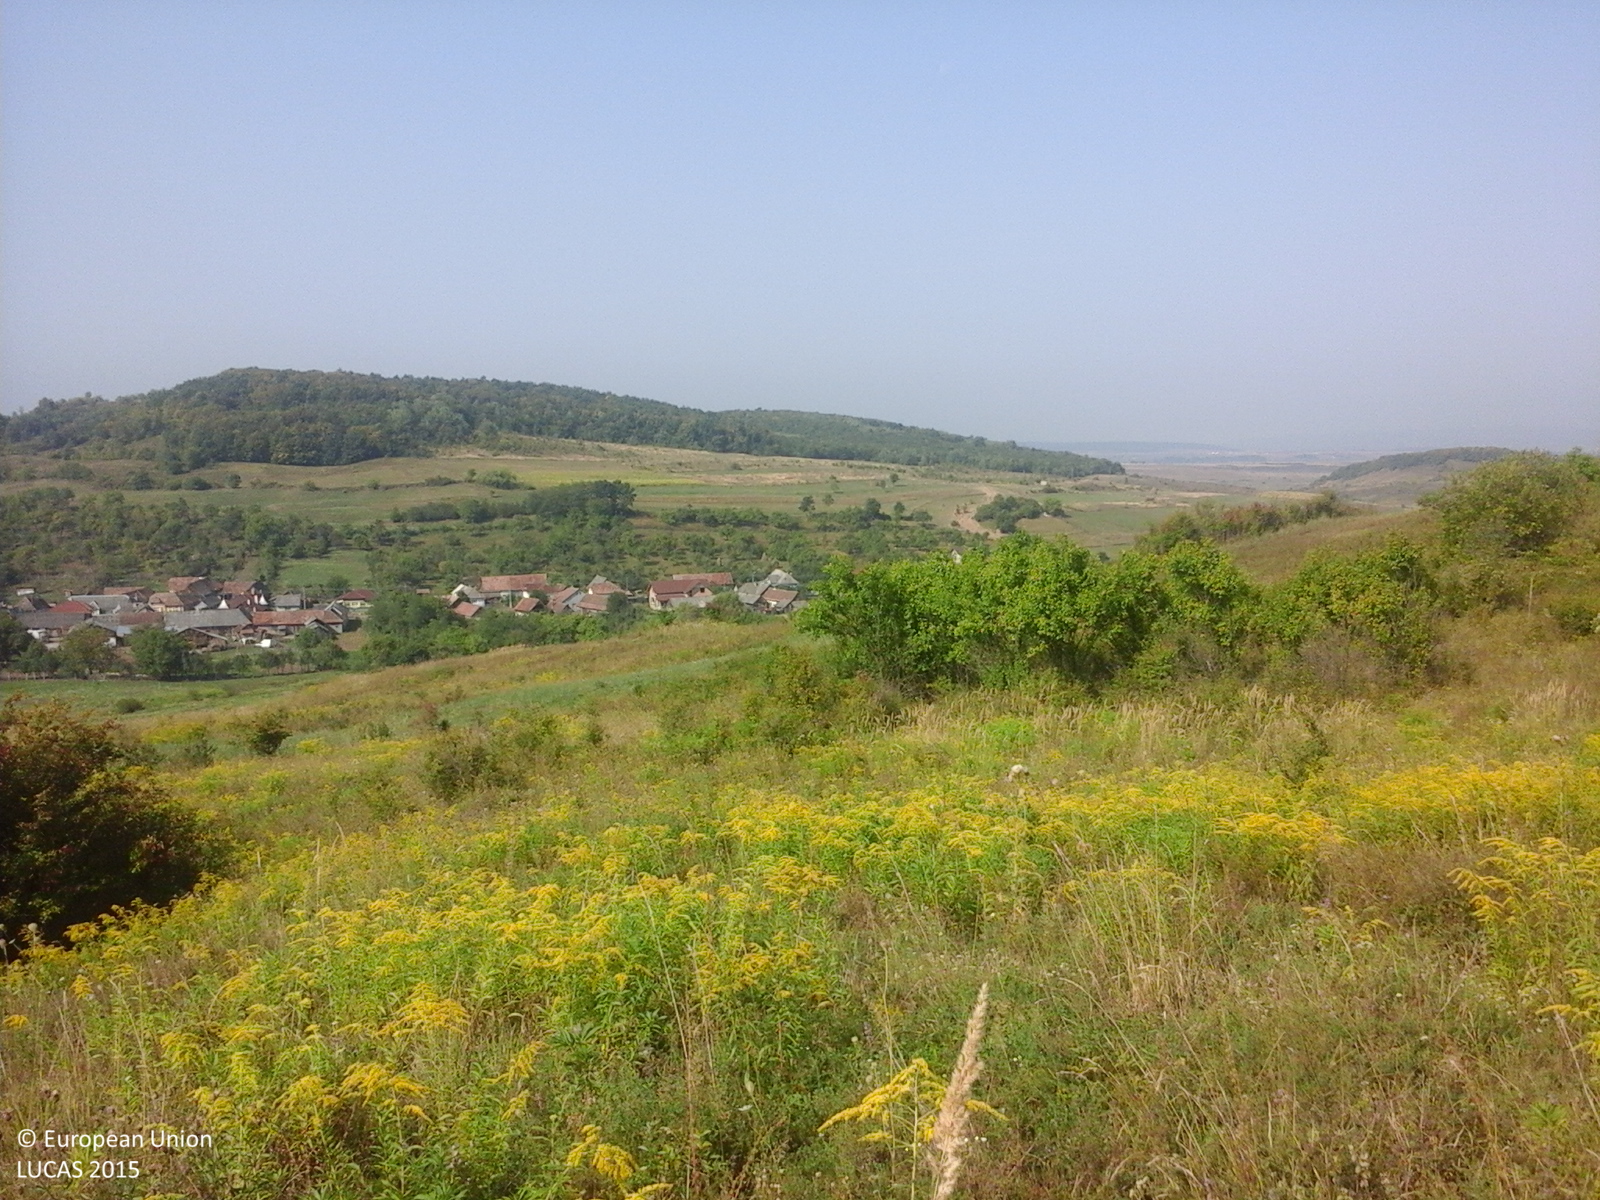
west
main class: Grassland
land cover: Spontaneously vegetated surfaces
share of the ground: > 75 %
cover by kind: herbaceous plants 100 %
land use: Fallow land
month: September
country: RO
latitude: 47.1478
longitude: 24.3705
